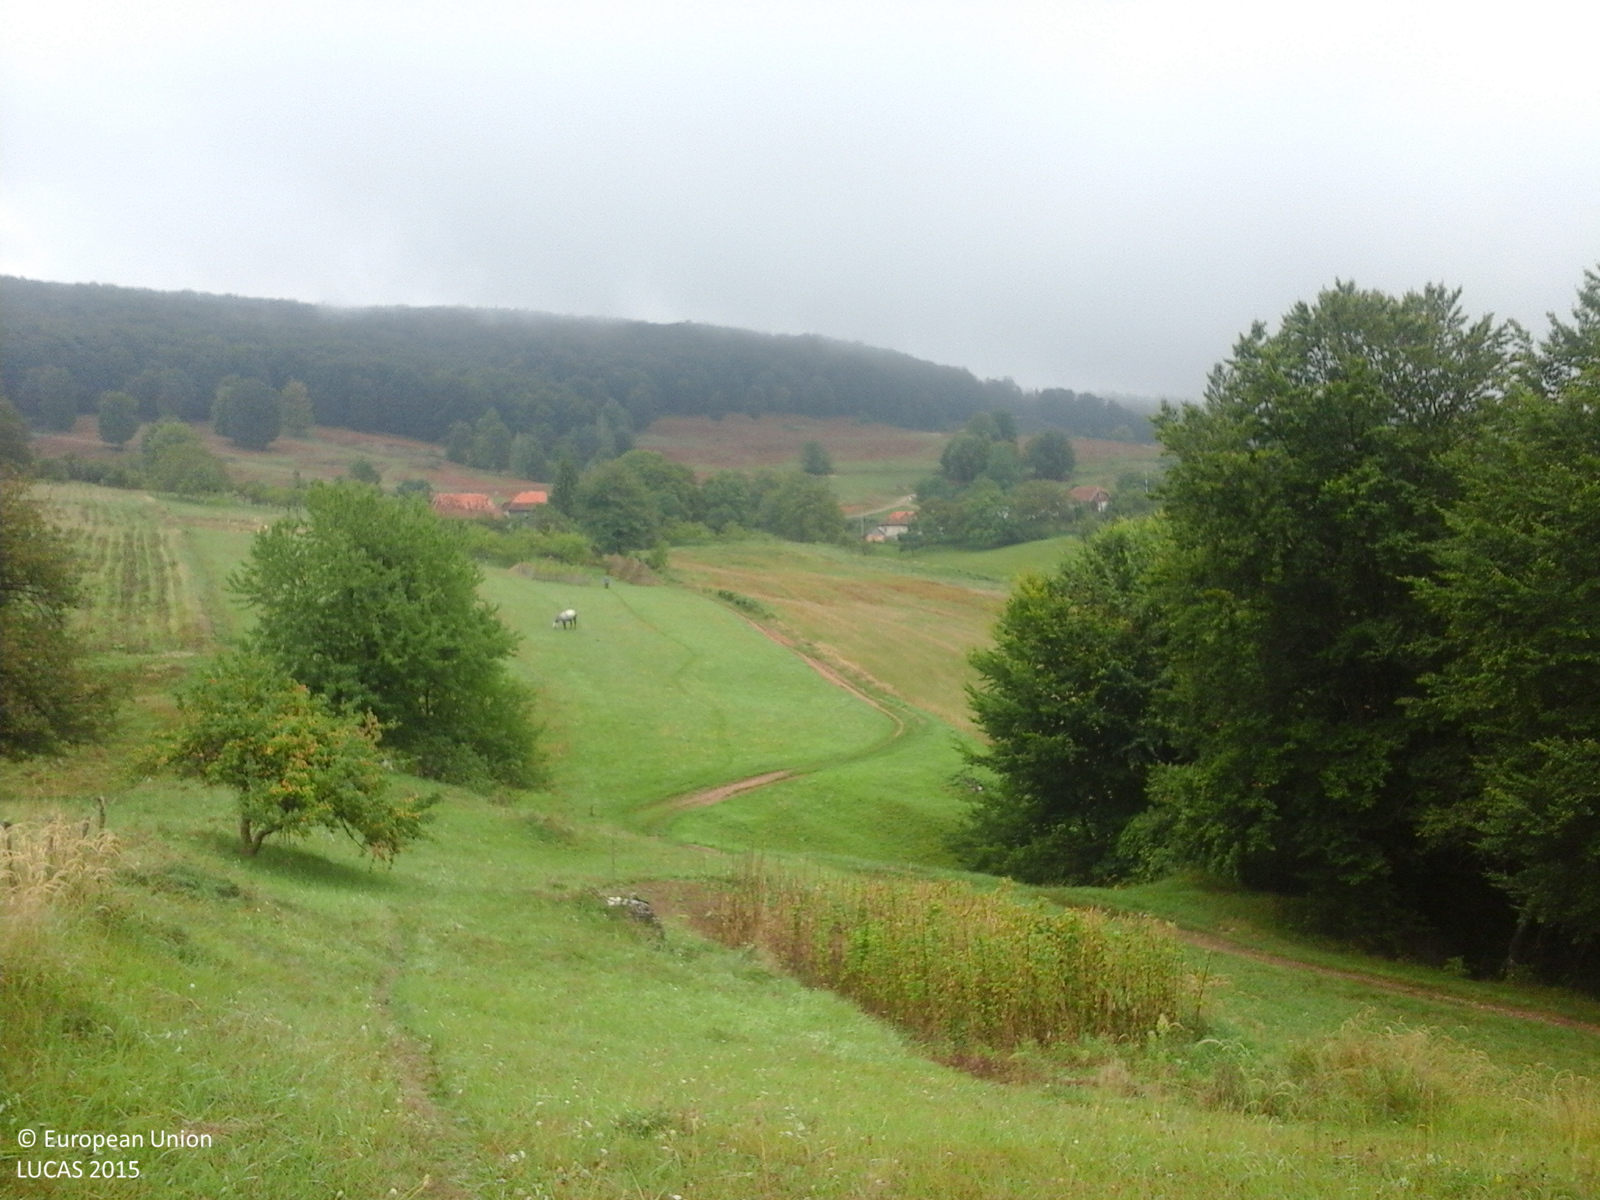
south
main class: Grassland
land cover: Grassland without tree/shrub cover
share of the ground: > 75 %
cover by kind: herbaceous plants 100 %
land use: Agriculture (excluding fallow land and kitchen gardens)
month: September
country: RO
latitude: 46.9124
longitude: 22.4608
